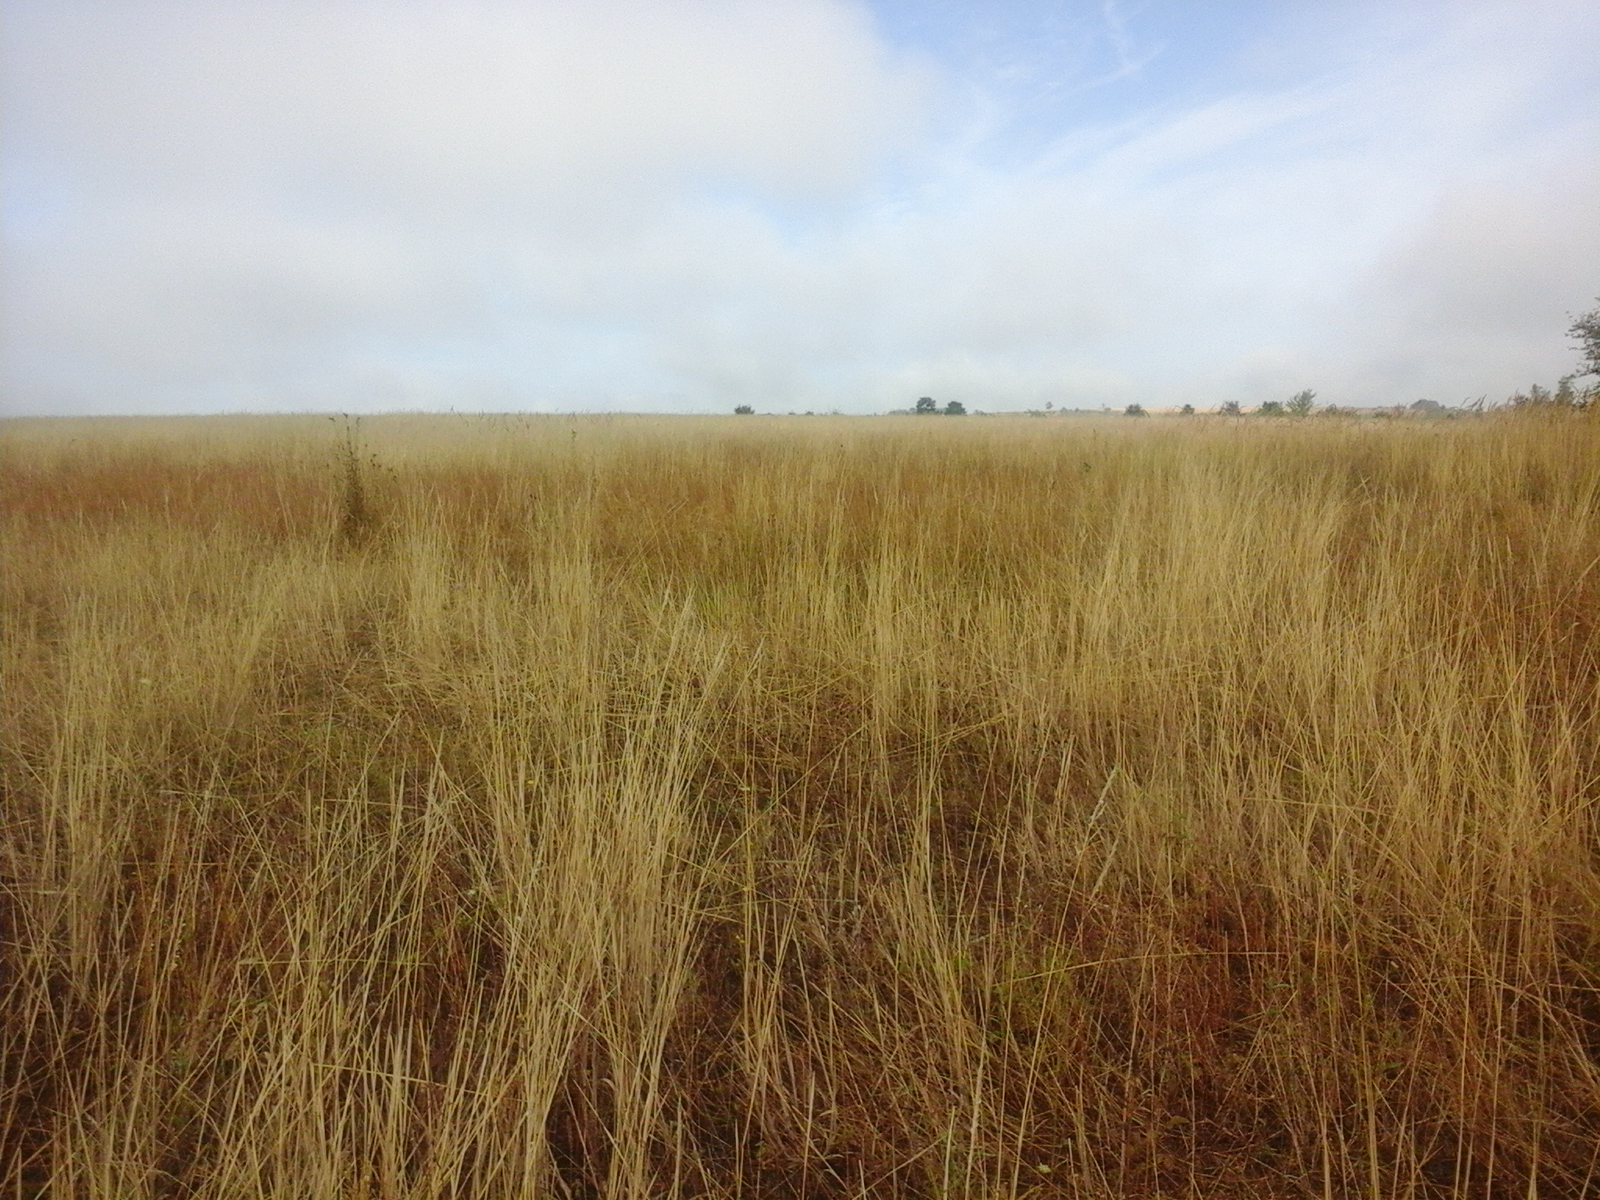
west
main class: Grassland
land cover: Grassland without tree/shrub cover
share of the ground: > 75 %
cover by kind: herbaceous plants 100 %
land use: Agriculture (excluding fallow land and kitchen gardens)
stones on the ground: < 10 %
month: August
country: RO
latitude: 45.1666
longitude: 21.6479
